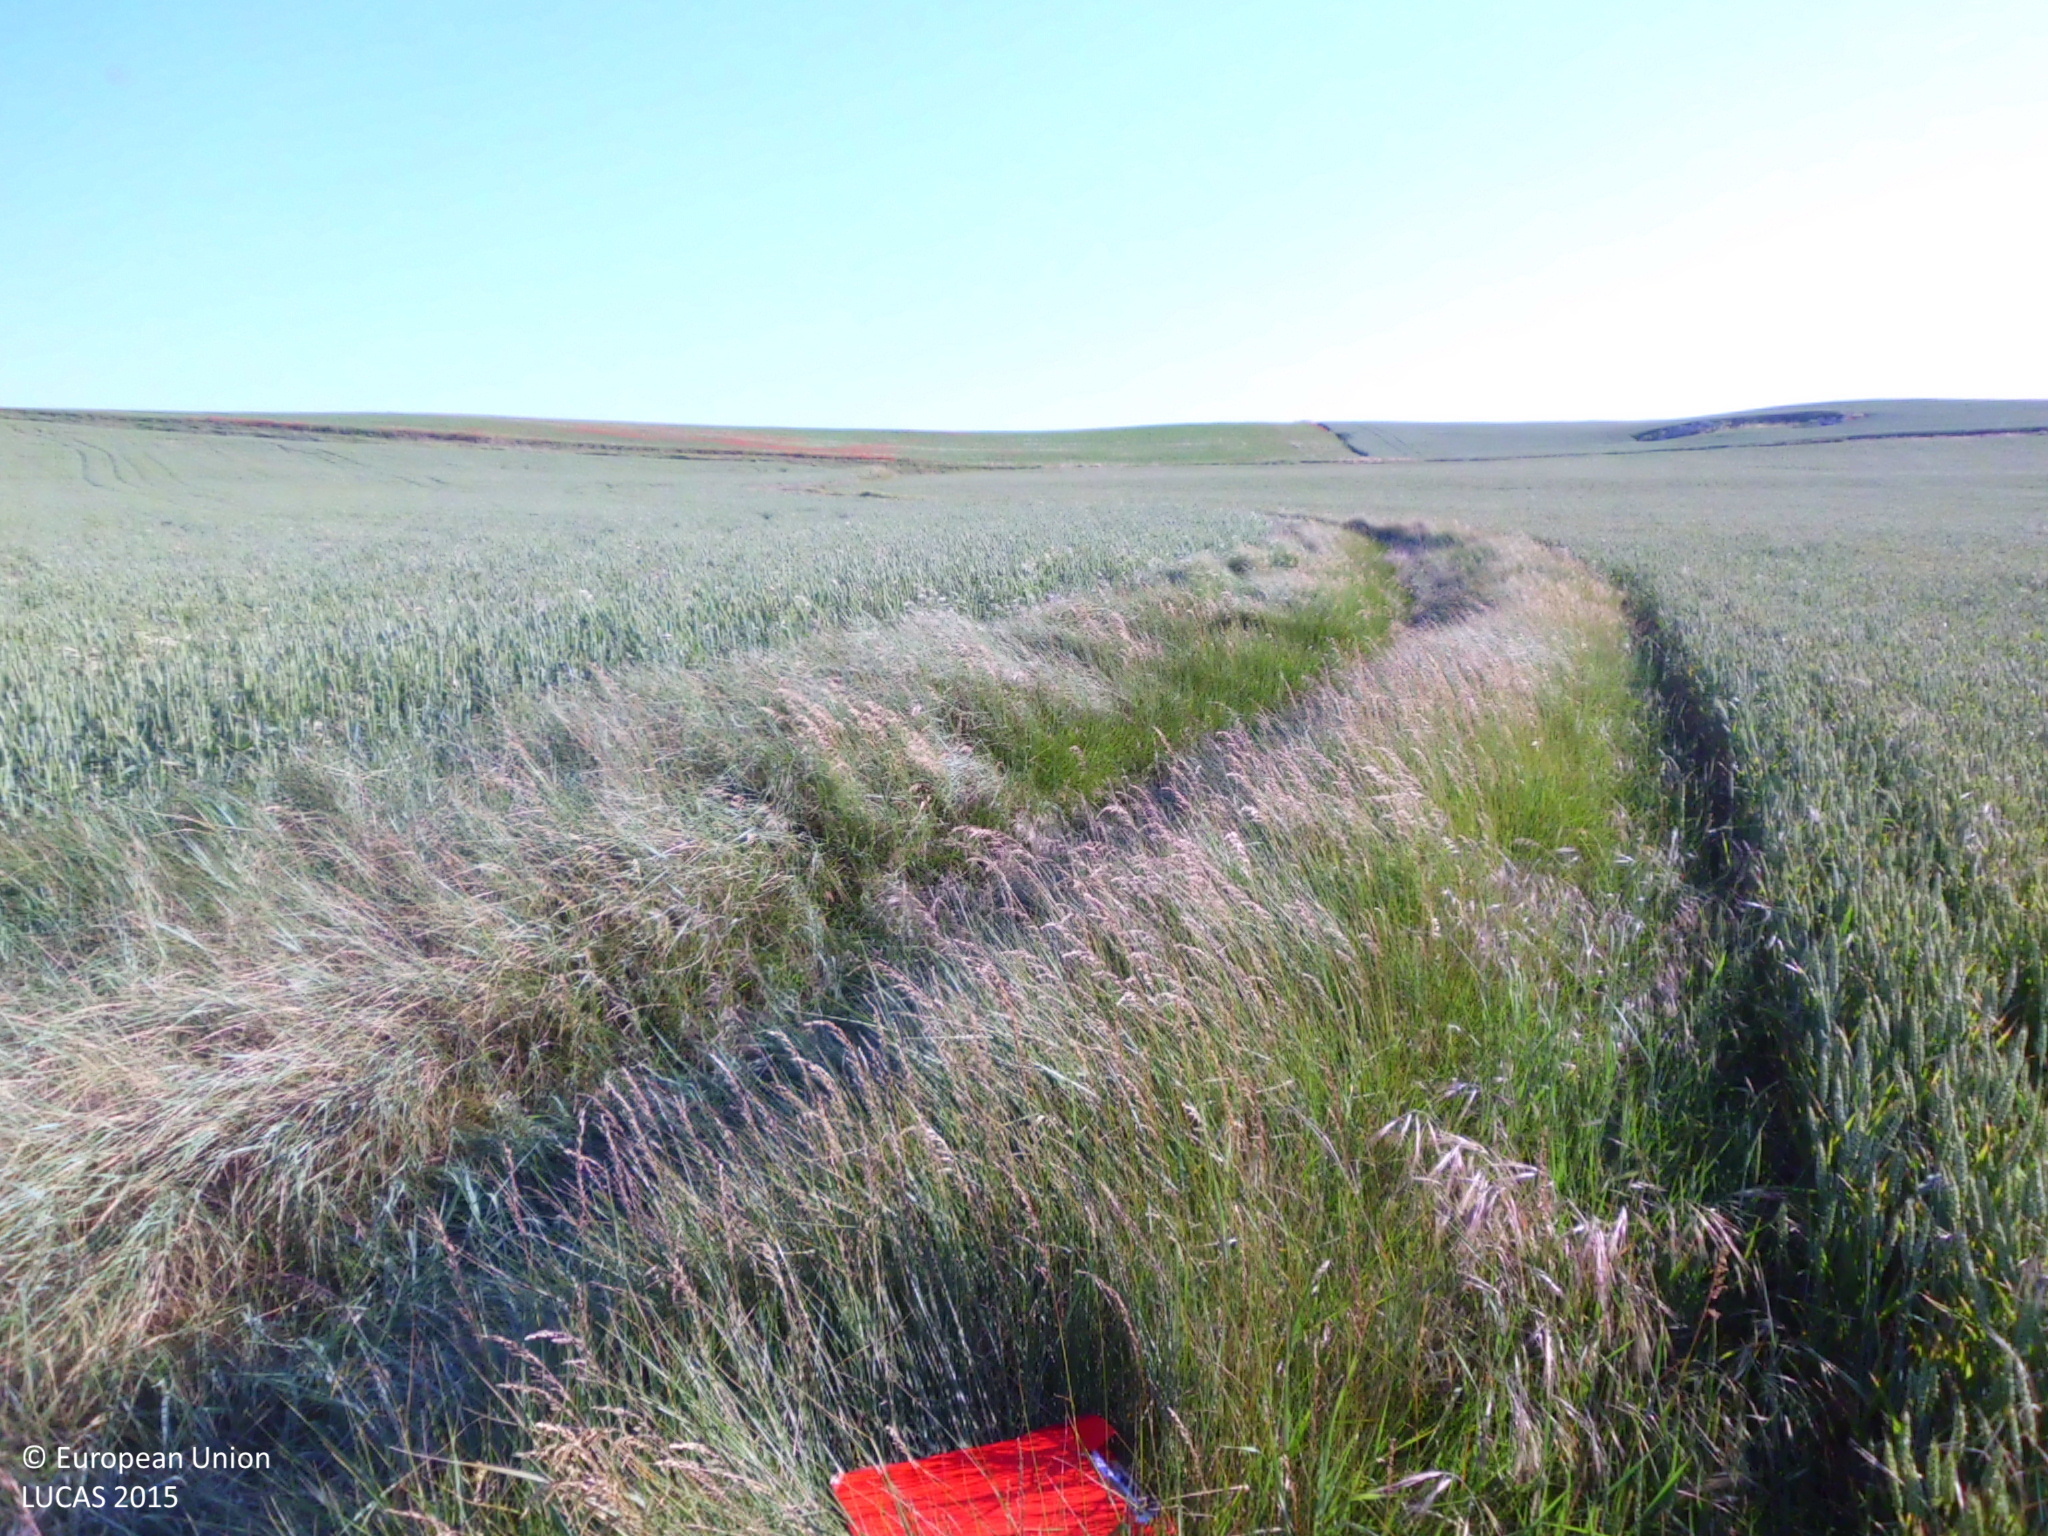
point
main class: Cropland
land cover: Common wheat
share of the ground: > 75 %
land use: Agriculture (excluding fallow land and kitchen gardens)
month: June
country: ES
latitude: 42.3548
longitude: -3.9903
